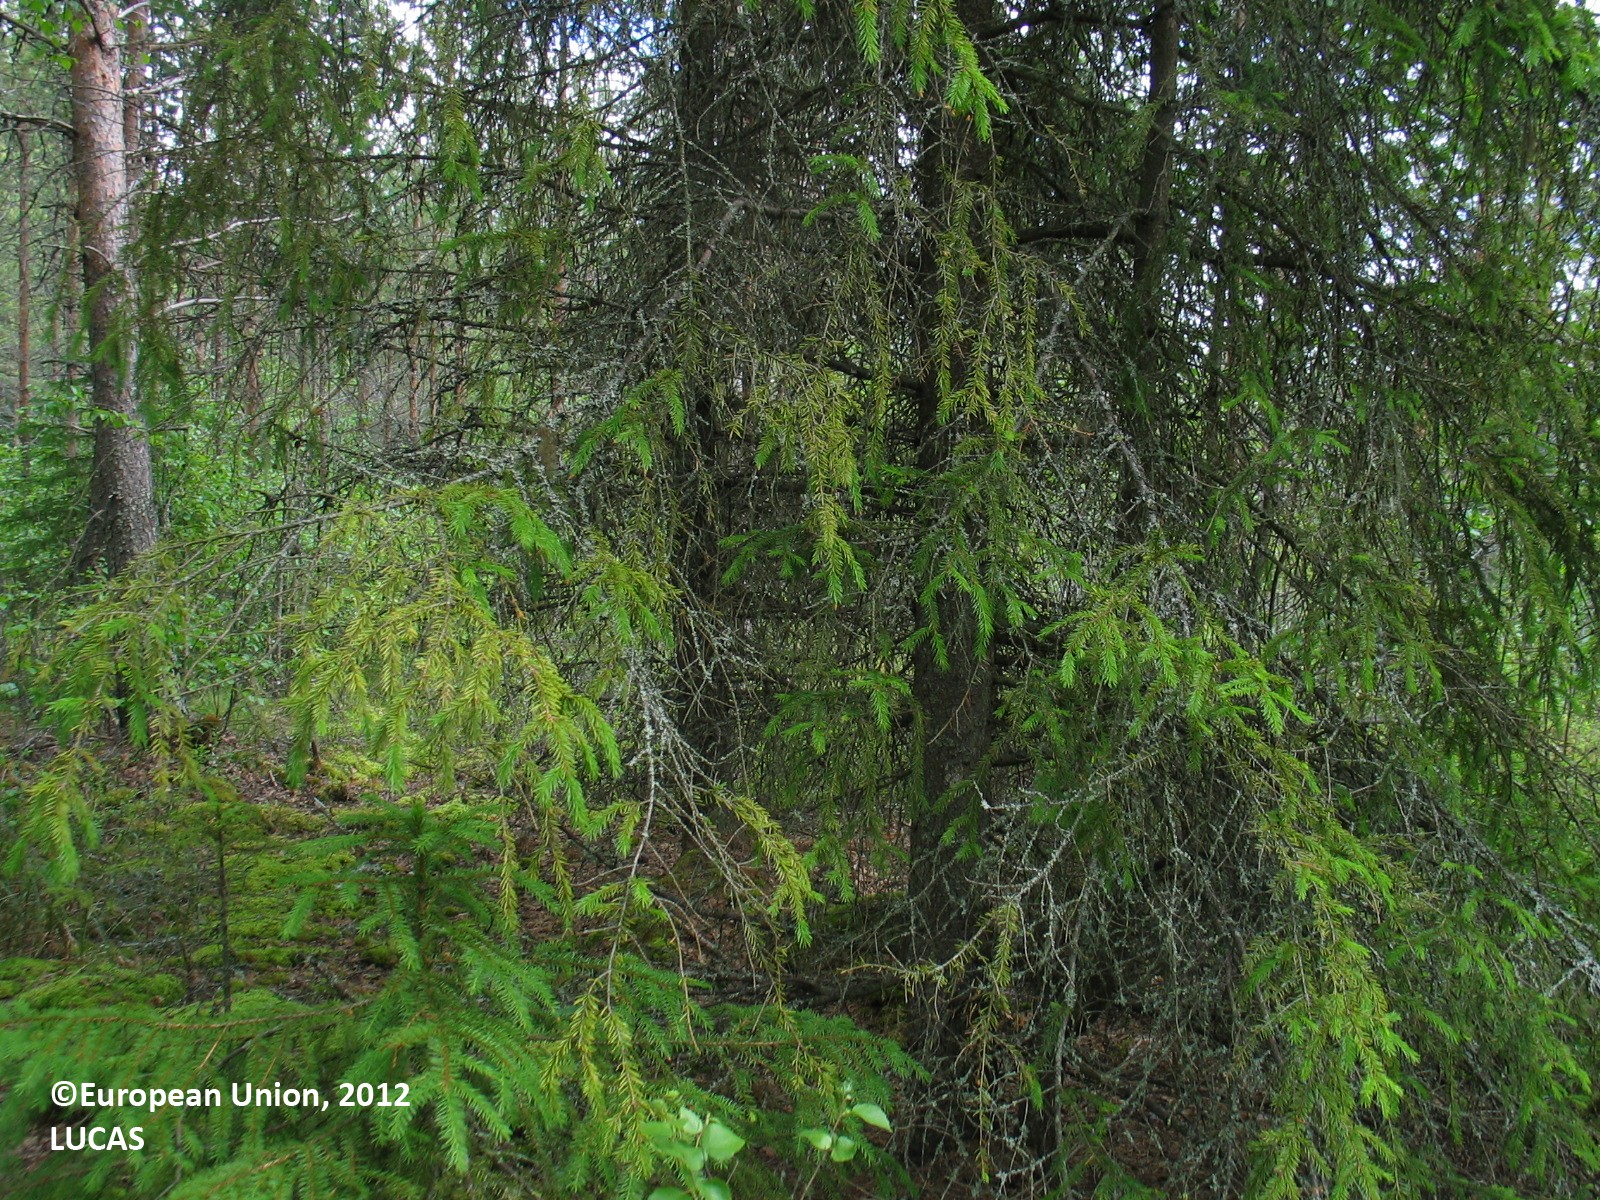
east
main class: Woodland
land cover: Other mixed woodland
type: boreal forest
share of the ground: 50 - 75 %
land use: Forestry
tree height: > 5 m
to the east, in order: Other mixed woodland; Pine dominated coniferous woodland; Ditches and canals; Pine dominated coniferous woodland
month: June
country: FI
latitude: 64.8257
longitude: 26.4809
